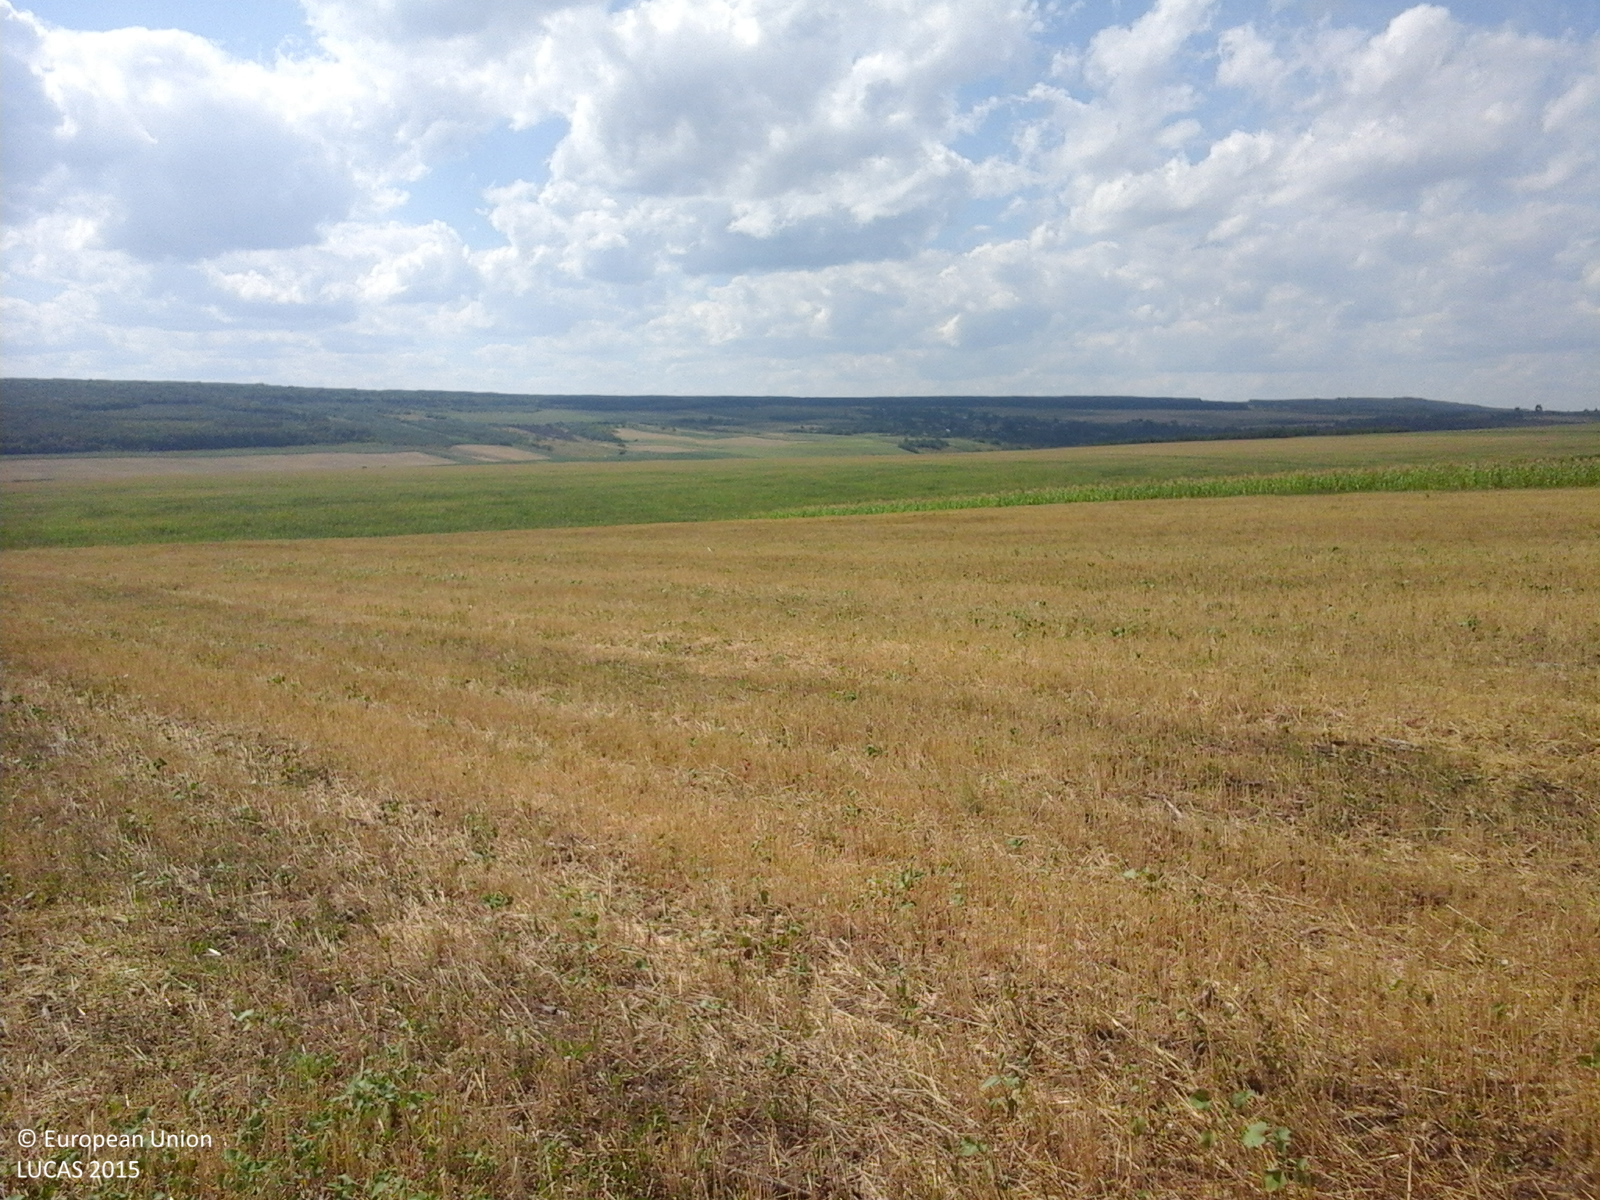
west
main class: Cropland
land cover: Common wheat
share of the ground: 10 - 25 %
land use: Agriculture (excluding fallow land and kitchen gardens)
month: July
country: RO
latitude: 46.4658
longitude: 27.7904
